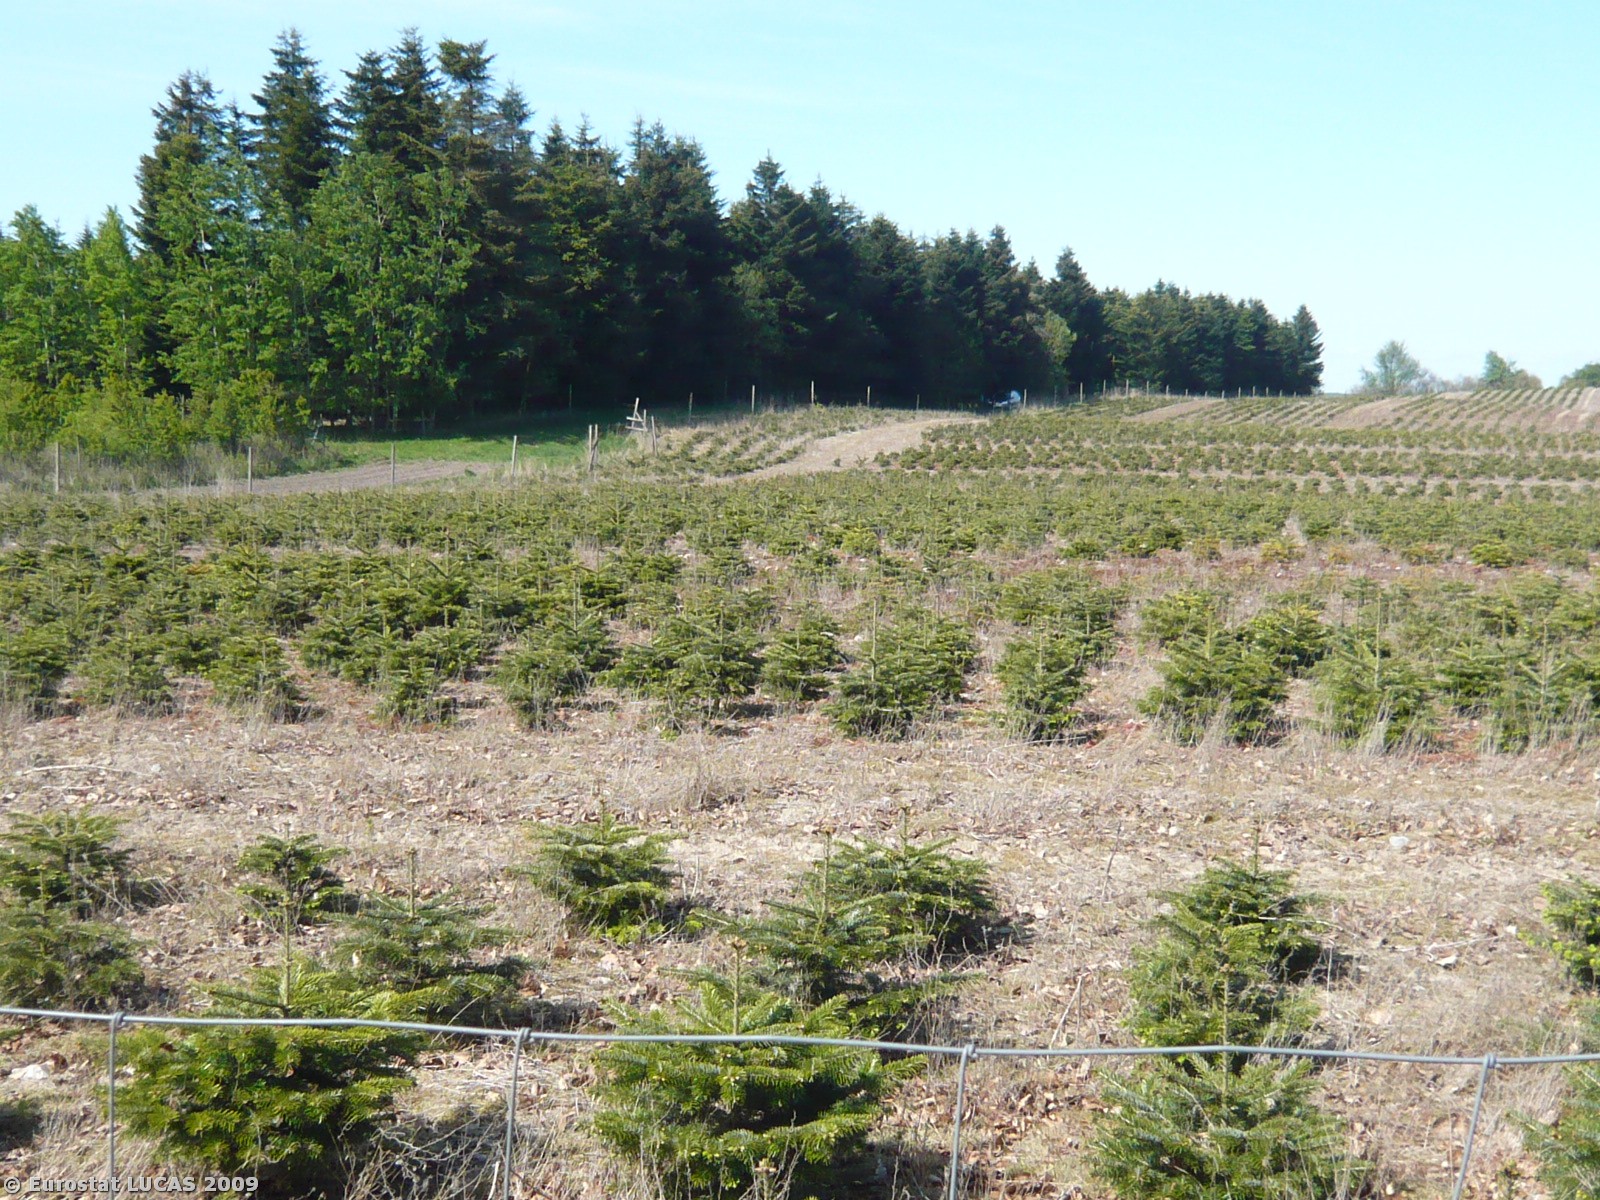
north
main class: Woodland
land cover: Coniferous woodland
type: plantations and self-sown exotic forest
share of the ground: 25 - 50 %
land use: Forestry
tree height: > 5 m
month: May
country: DK
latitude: 55.2557
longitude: 11.9652
